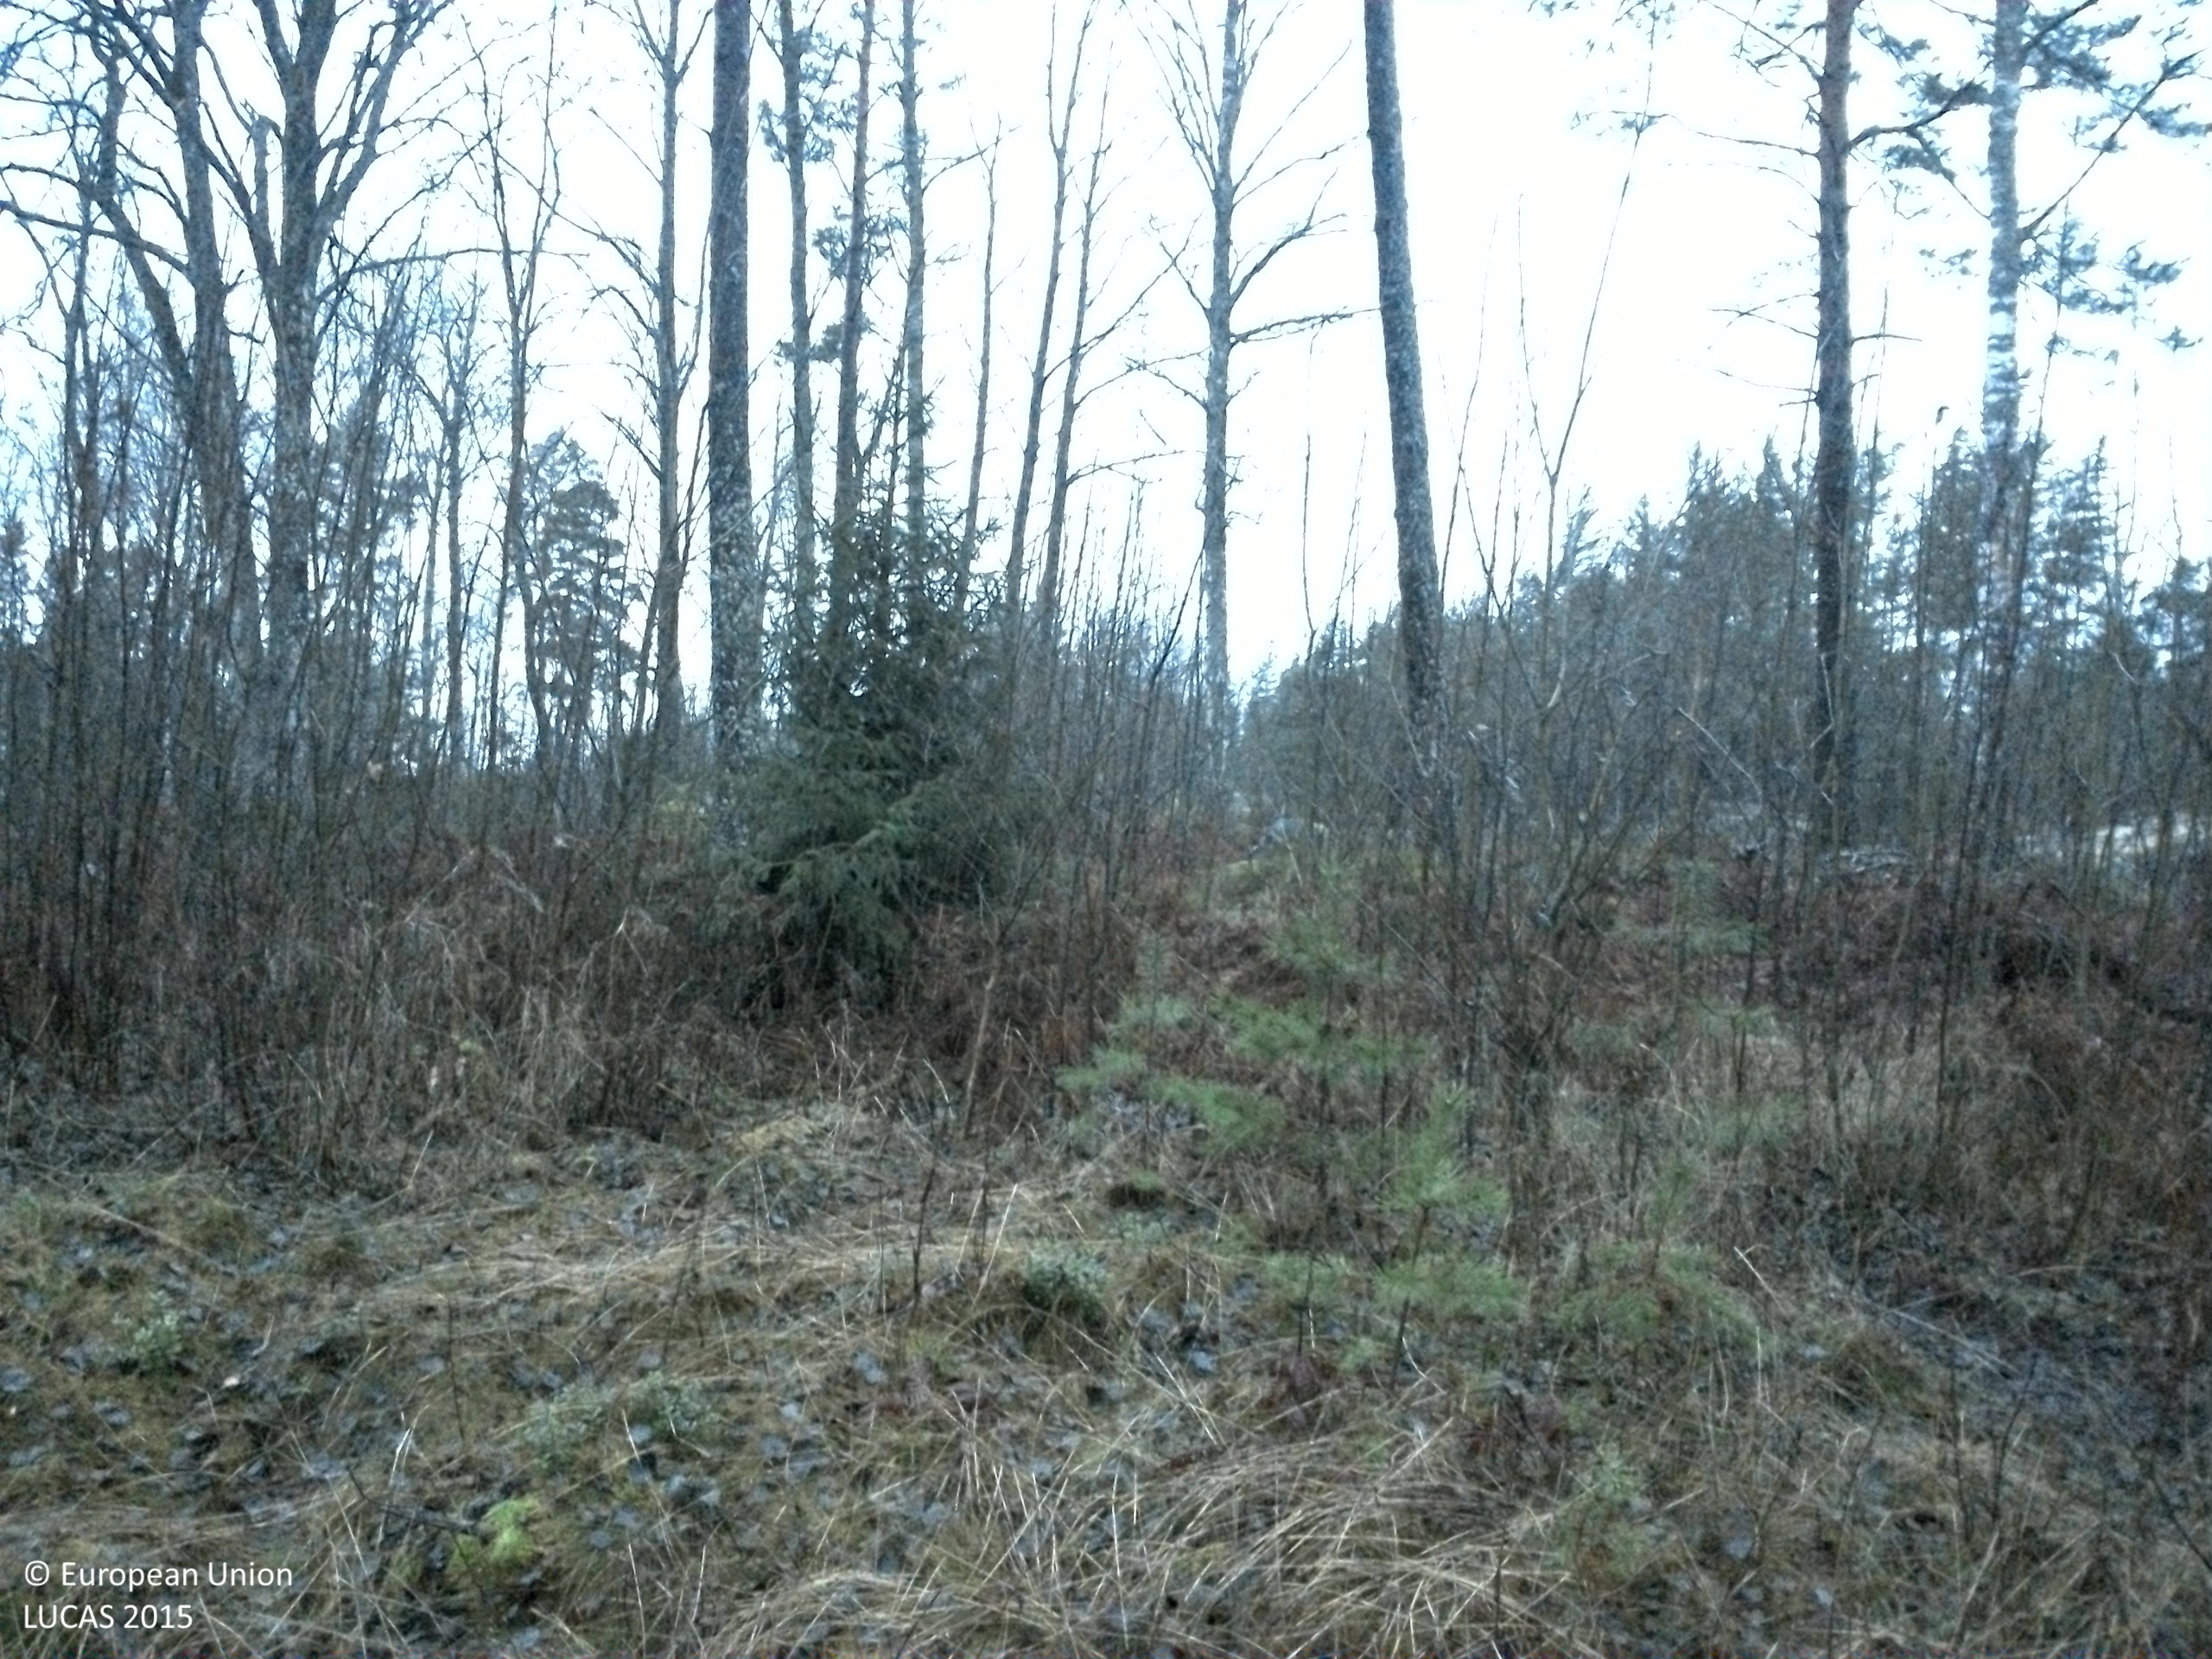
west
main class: Woodland
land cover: Pine dominated mixed woodland
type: boreal forest
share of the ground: 50 - 75 %
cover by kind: broadleaved forest trees 40 %, coniferous forest trees 20 %, herbaceous plants 20 %, consolidated bare surface 15 %, lichens and mosses 5 %
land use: Forestry
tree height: > 5 m
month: December
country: SE
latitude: 59.3027
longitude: 16.2272
